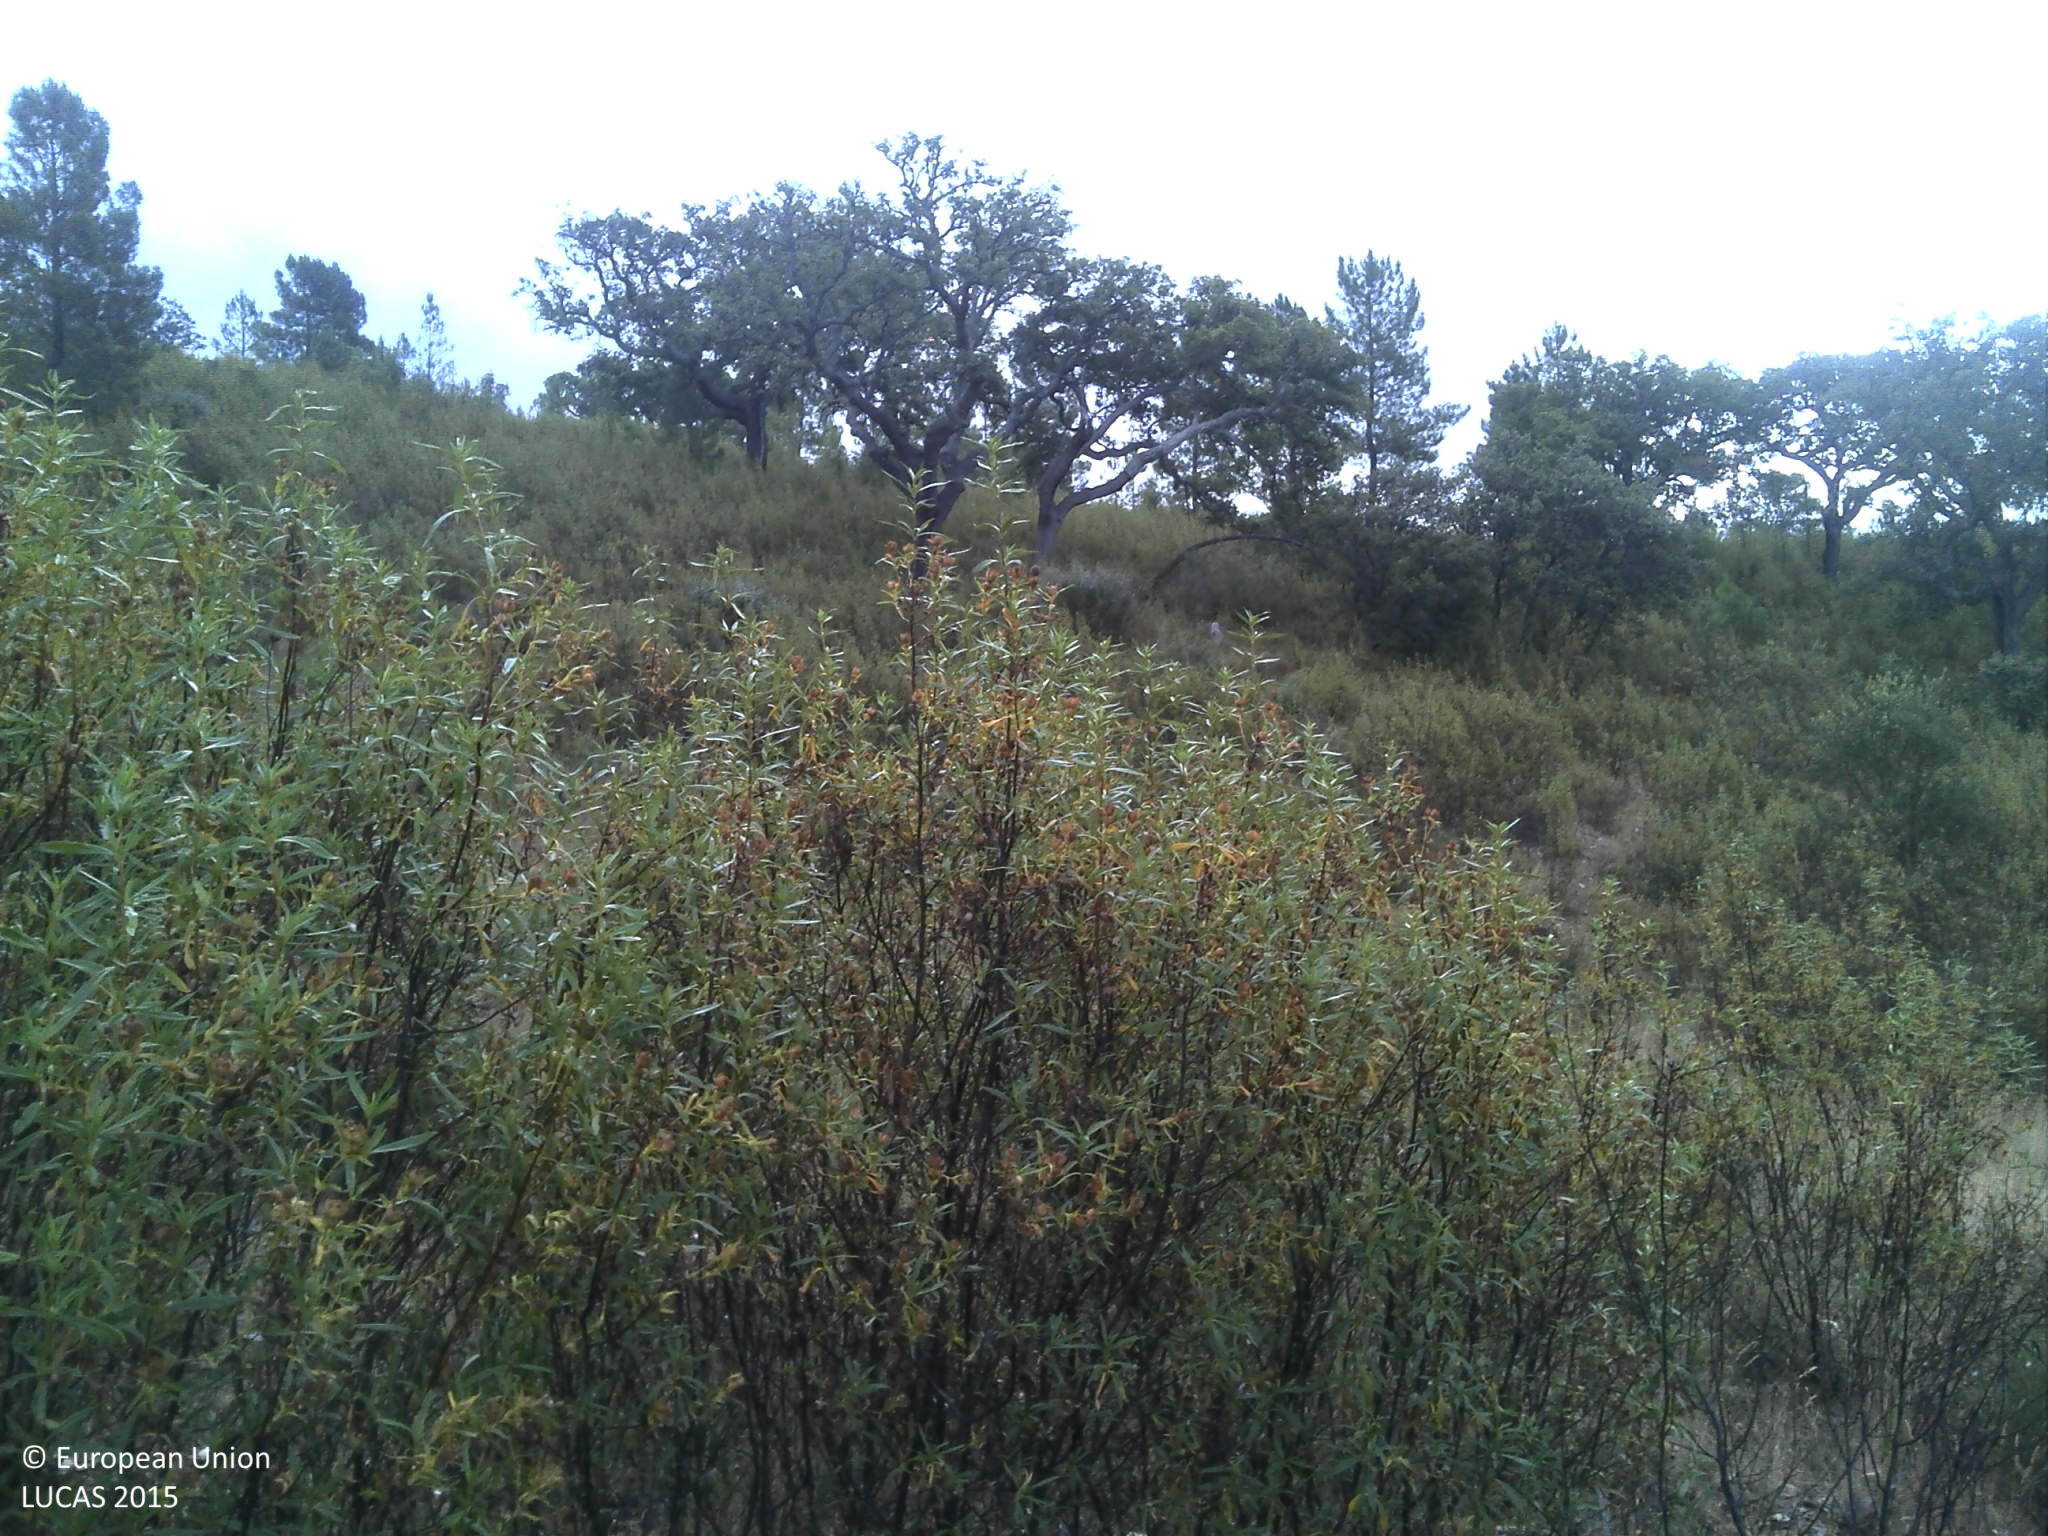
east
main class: Woodland
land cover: Broadleaved woodland
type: broadleaved evergreen forest
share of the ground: 25 - 50 %
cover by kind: broadleaved forest trees 40 %, shrubs 40 %, herbaceous plants 10 %, unconsolidated bare surface 5 %
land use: Forestry
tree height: > 5 m
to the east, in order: Broadleaved woodland; Shrubland with sparse tree cover; Tracks; Broadleaved woodland
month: June
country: PT
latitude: 40.1904
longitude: -7.2125
